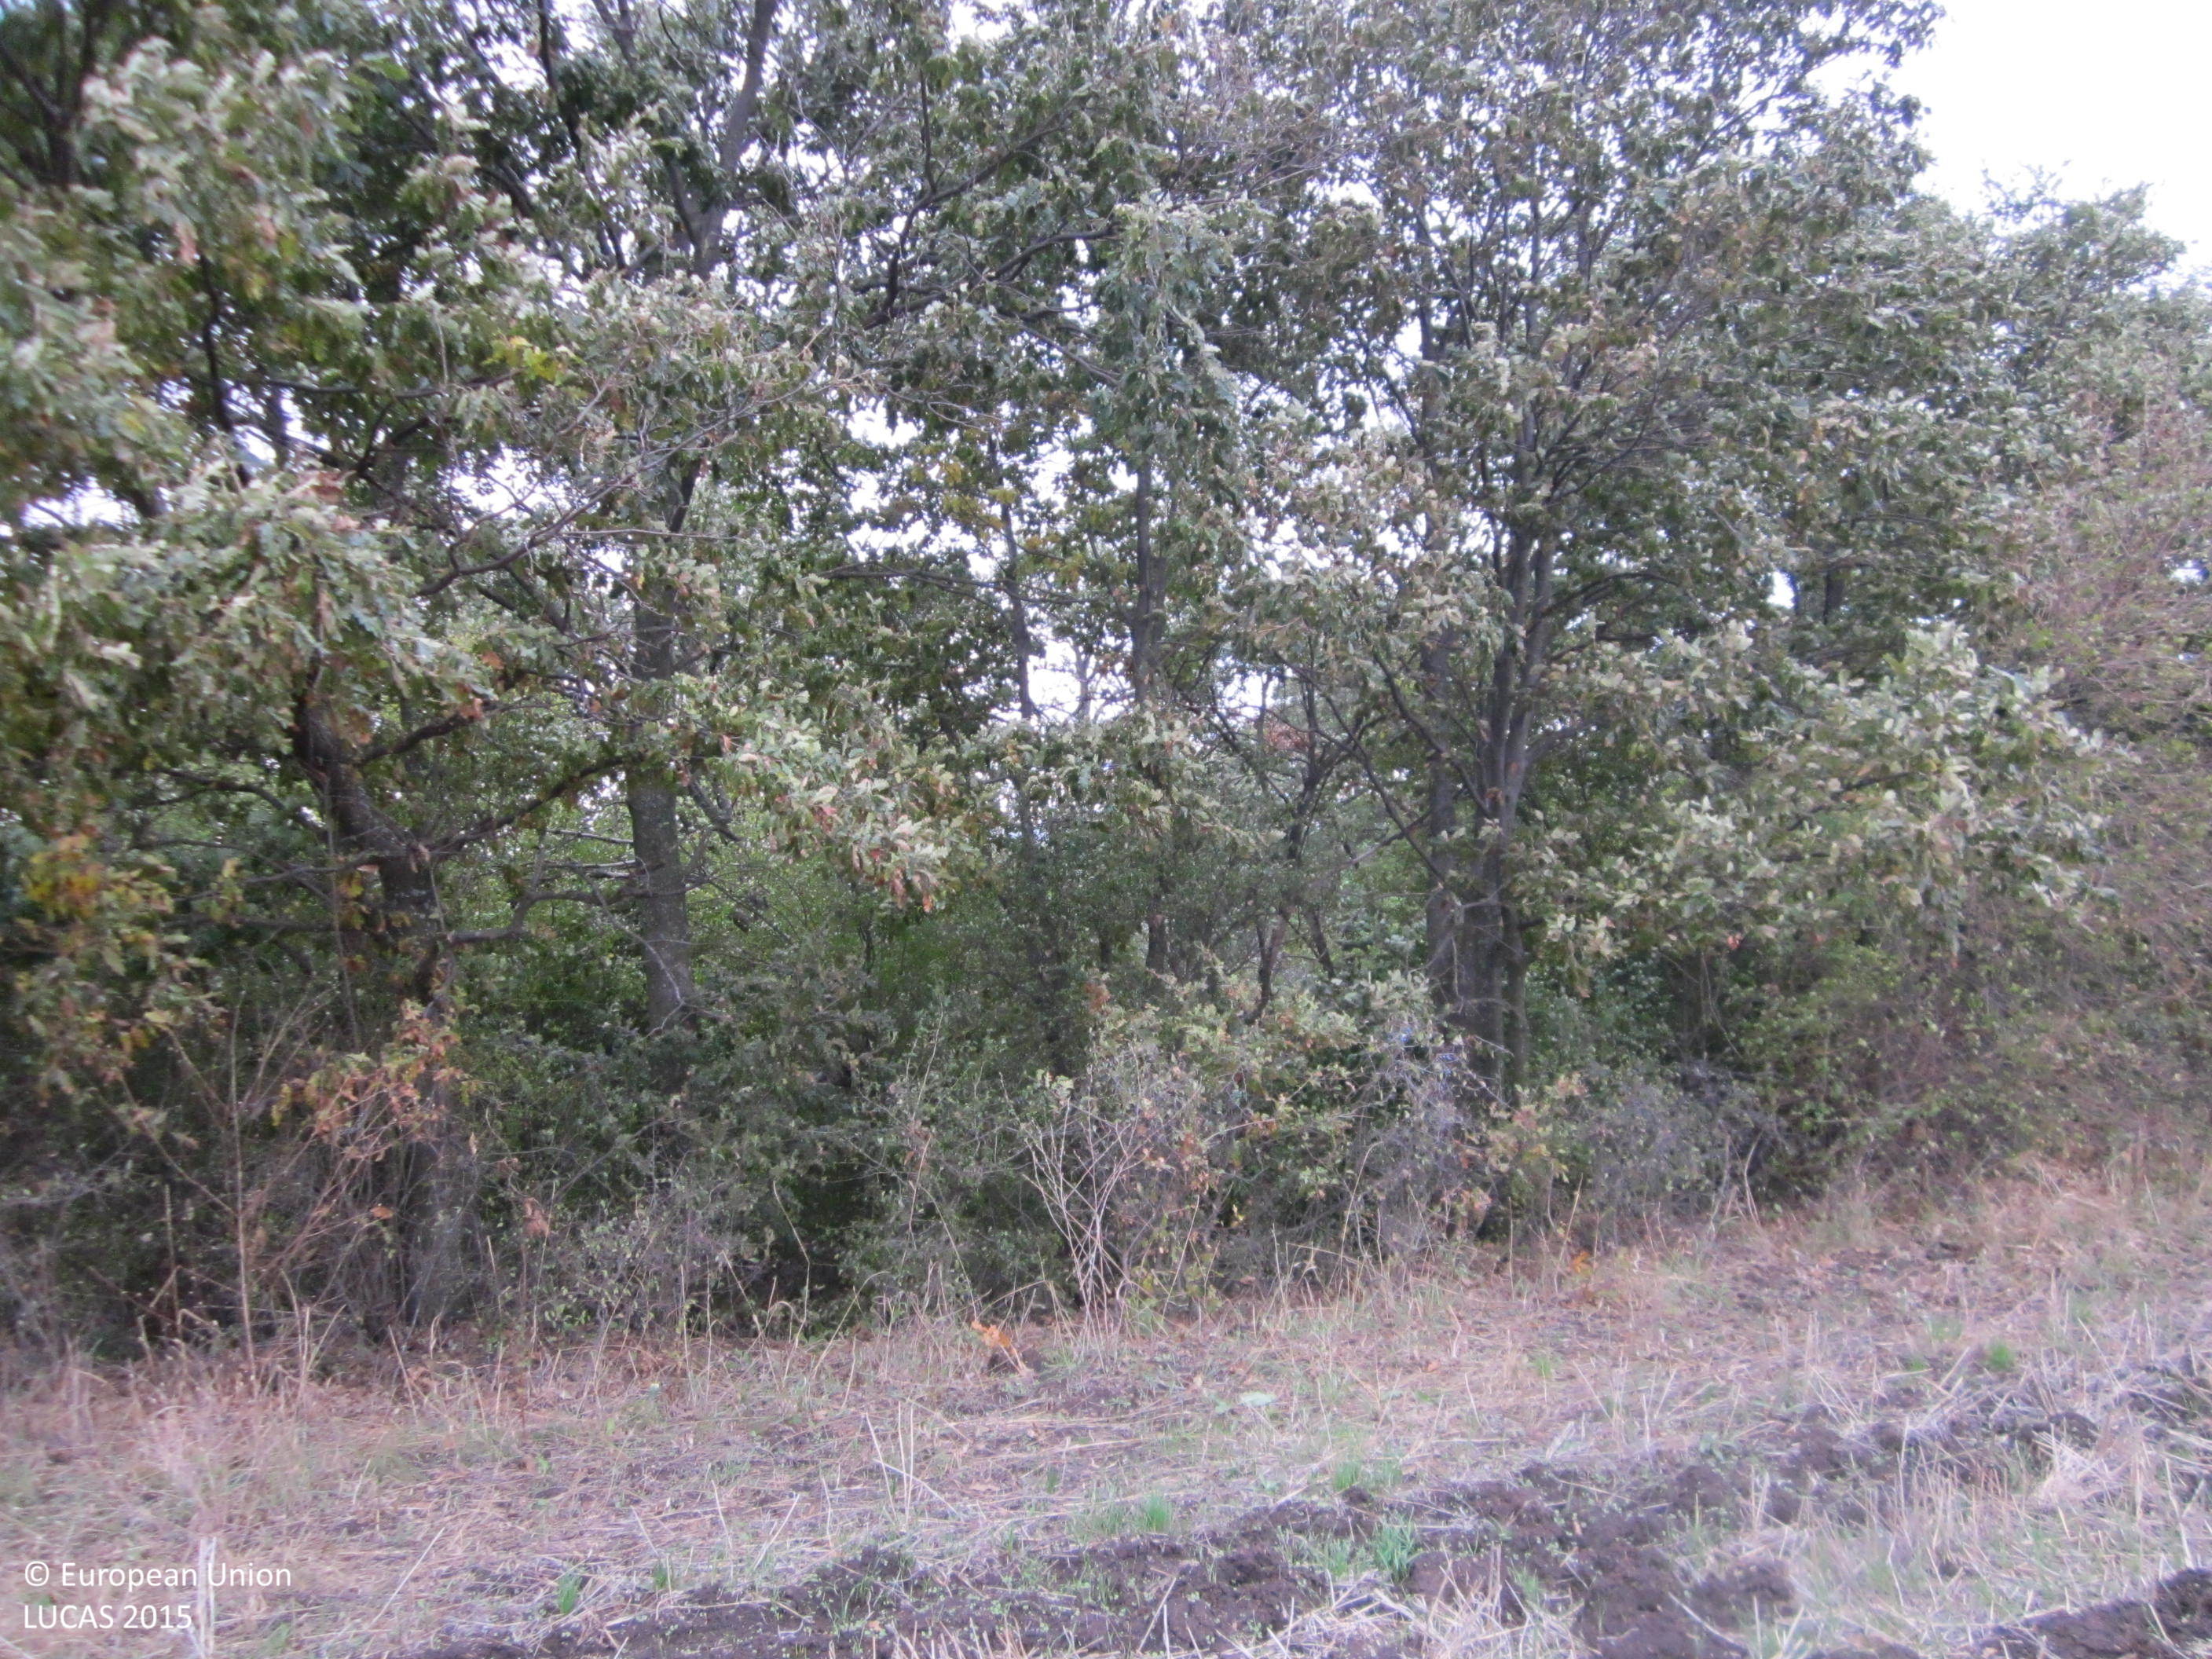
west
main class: Cropland
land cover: Common wheat
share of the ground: 25 - 50 %
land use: Agriculture (excluding fallow land and kitchen gardens)
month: October
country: BG
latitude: 42.3820
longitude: 26.8980
